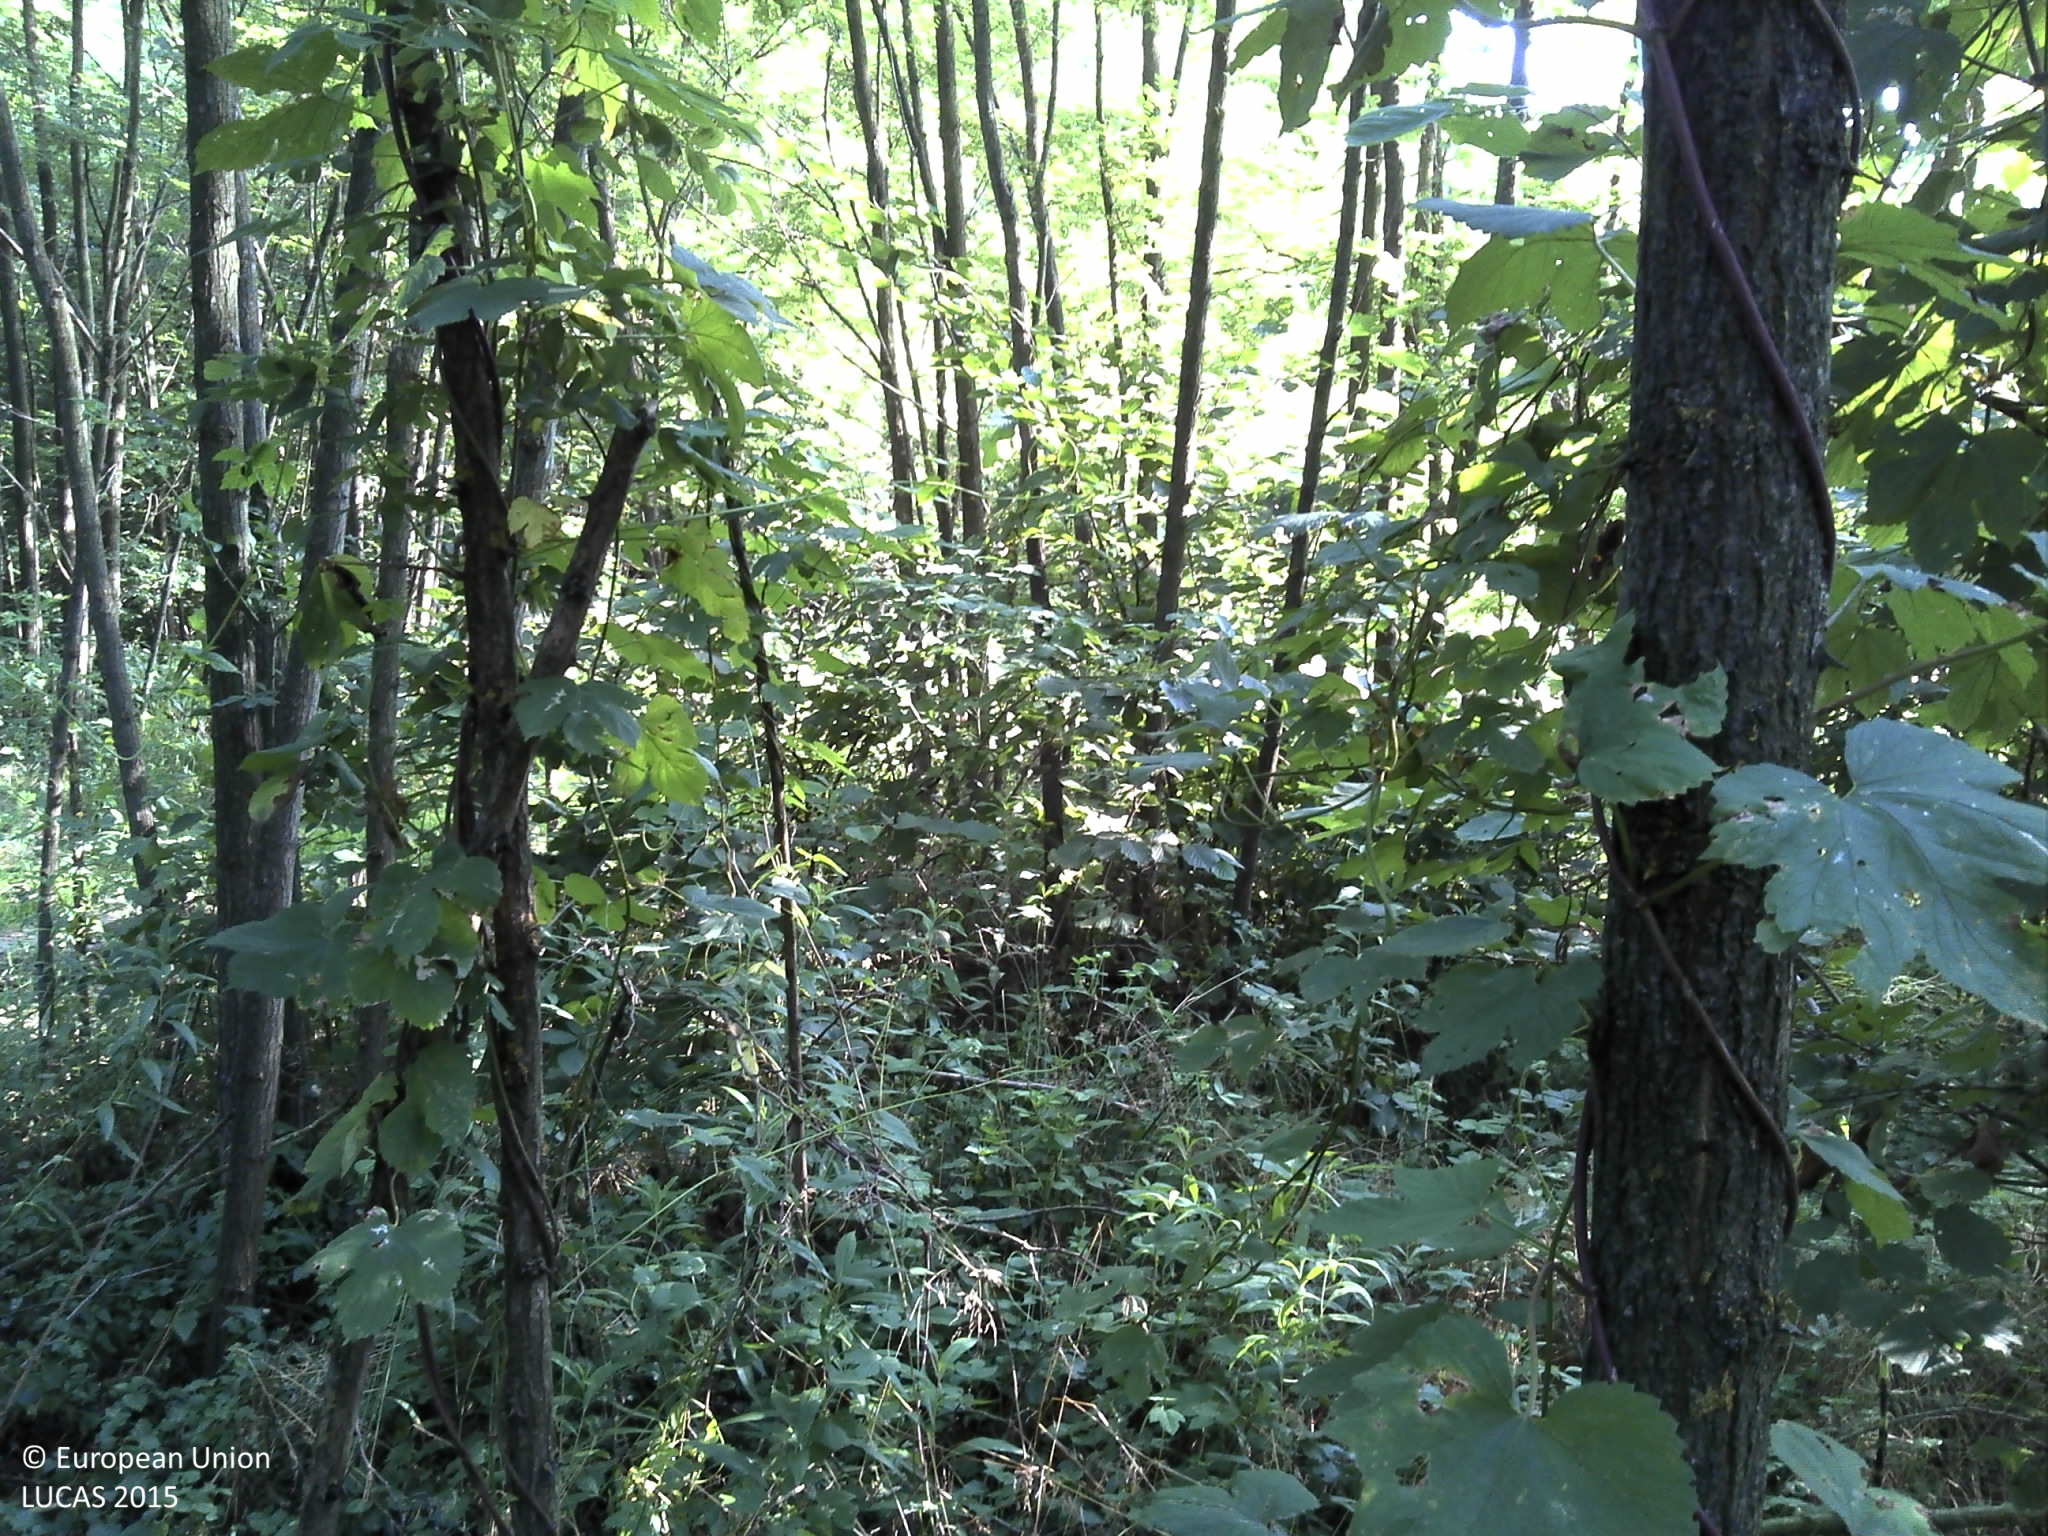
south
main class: Shrubland
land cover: Shrubland with sparse tree cover
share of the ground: > 75 %
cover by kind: shrubs 95 %, broadleaved forest trees 5 %
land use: Semi-natural and natural areas not in use
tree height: < 5 m
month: July
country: HR
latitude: 45.5073
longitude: 16.7184
